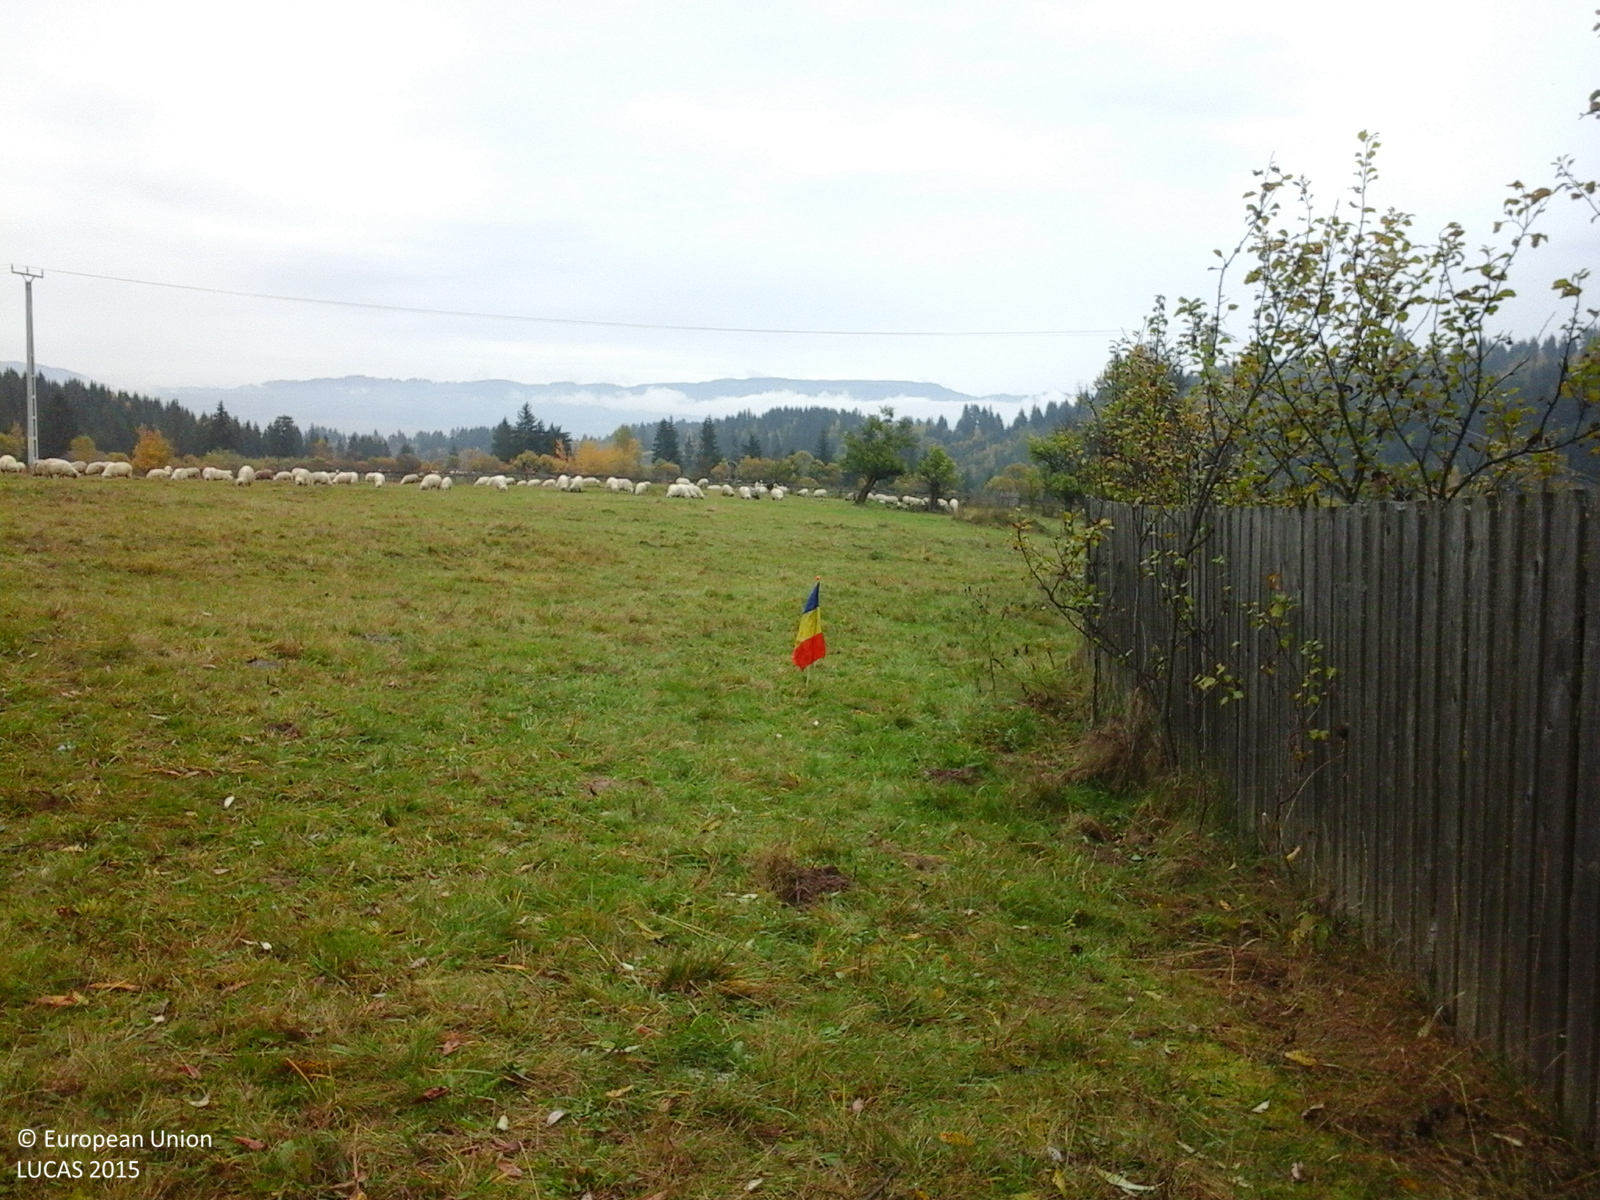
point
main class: Grassland
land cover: Grassland without tree/shrub cover
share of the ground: > 75 %
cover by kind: herbaceous plants 100 %
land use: Agriculture (excluding fallow land and kitchen gardens)
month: October
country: RO
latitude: 46.9059
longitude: 25.3232
